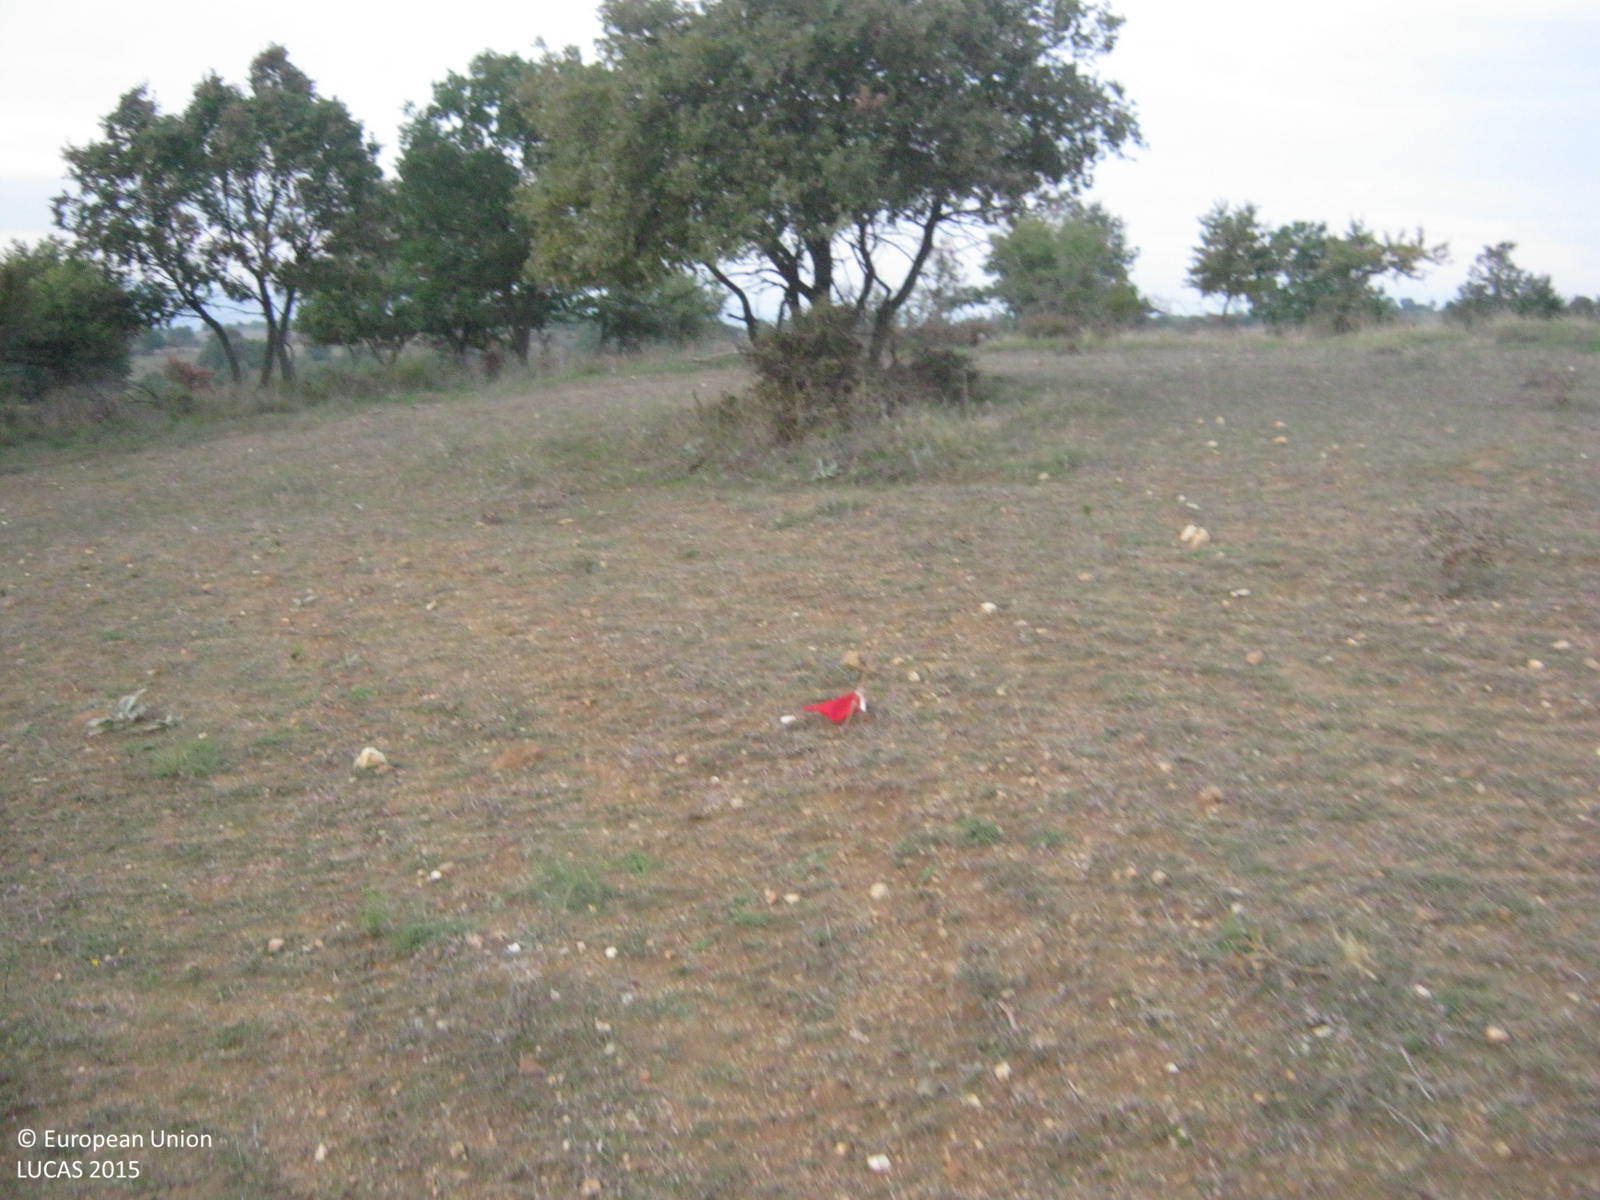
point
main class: Grassland
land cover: Grassland with sparse tree/shrub cover
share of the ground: > 75 %
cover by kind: herbaceous plants 75 %, unconsolidated bare surface 20 %, broadleaved forest trees 5 %
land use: Agriculture (excluding fallow land and kitchen gardens)
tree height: < 5 m
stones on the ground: 25 - 50 %
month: October
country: GR
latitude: 41.0249
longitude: 23.0114
